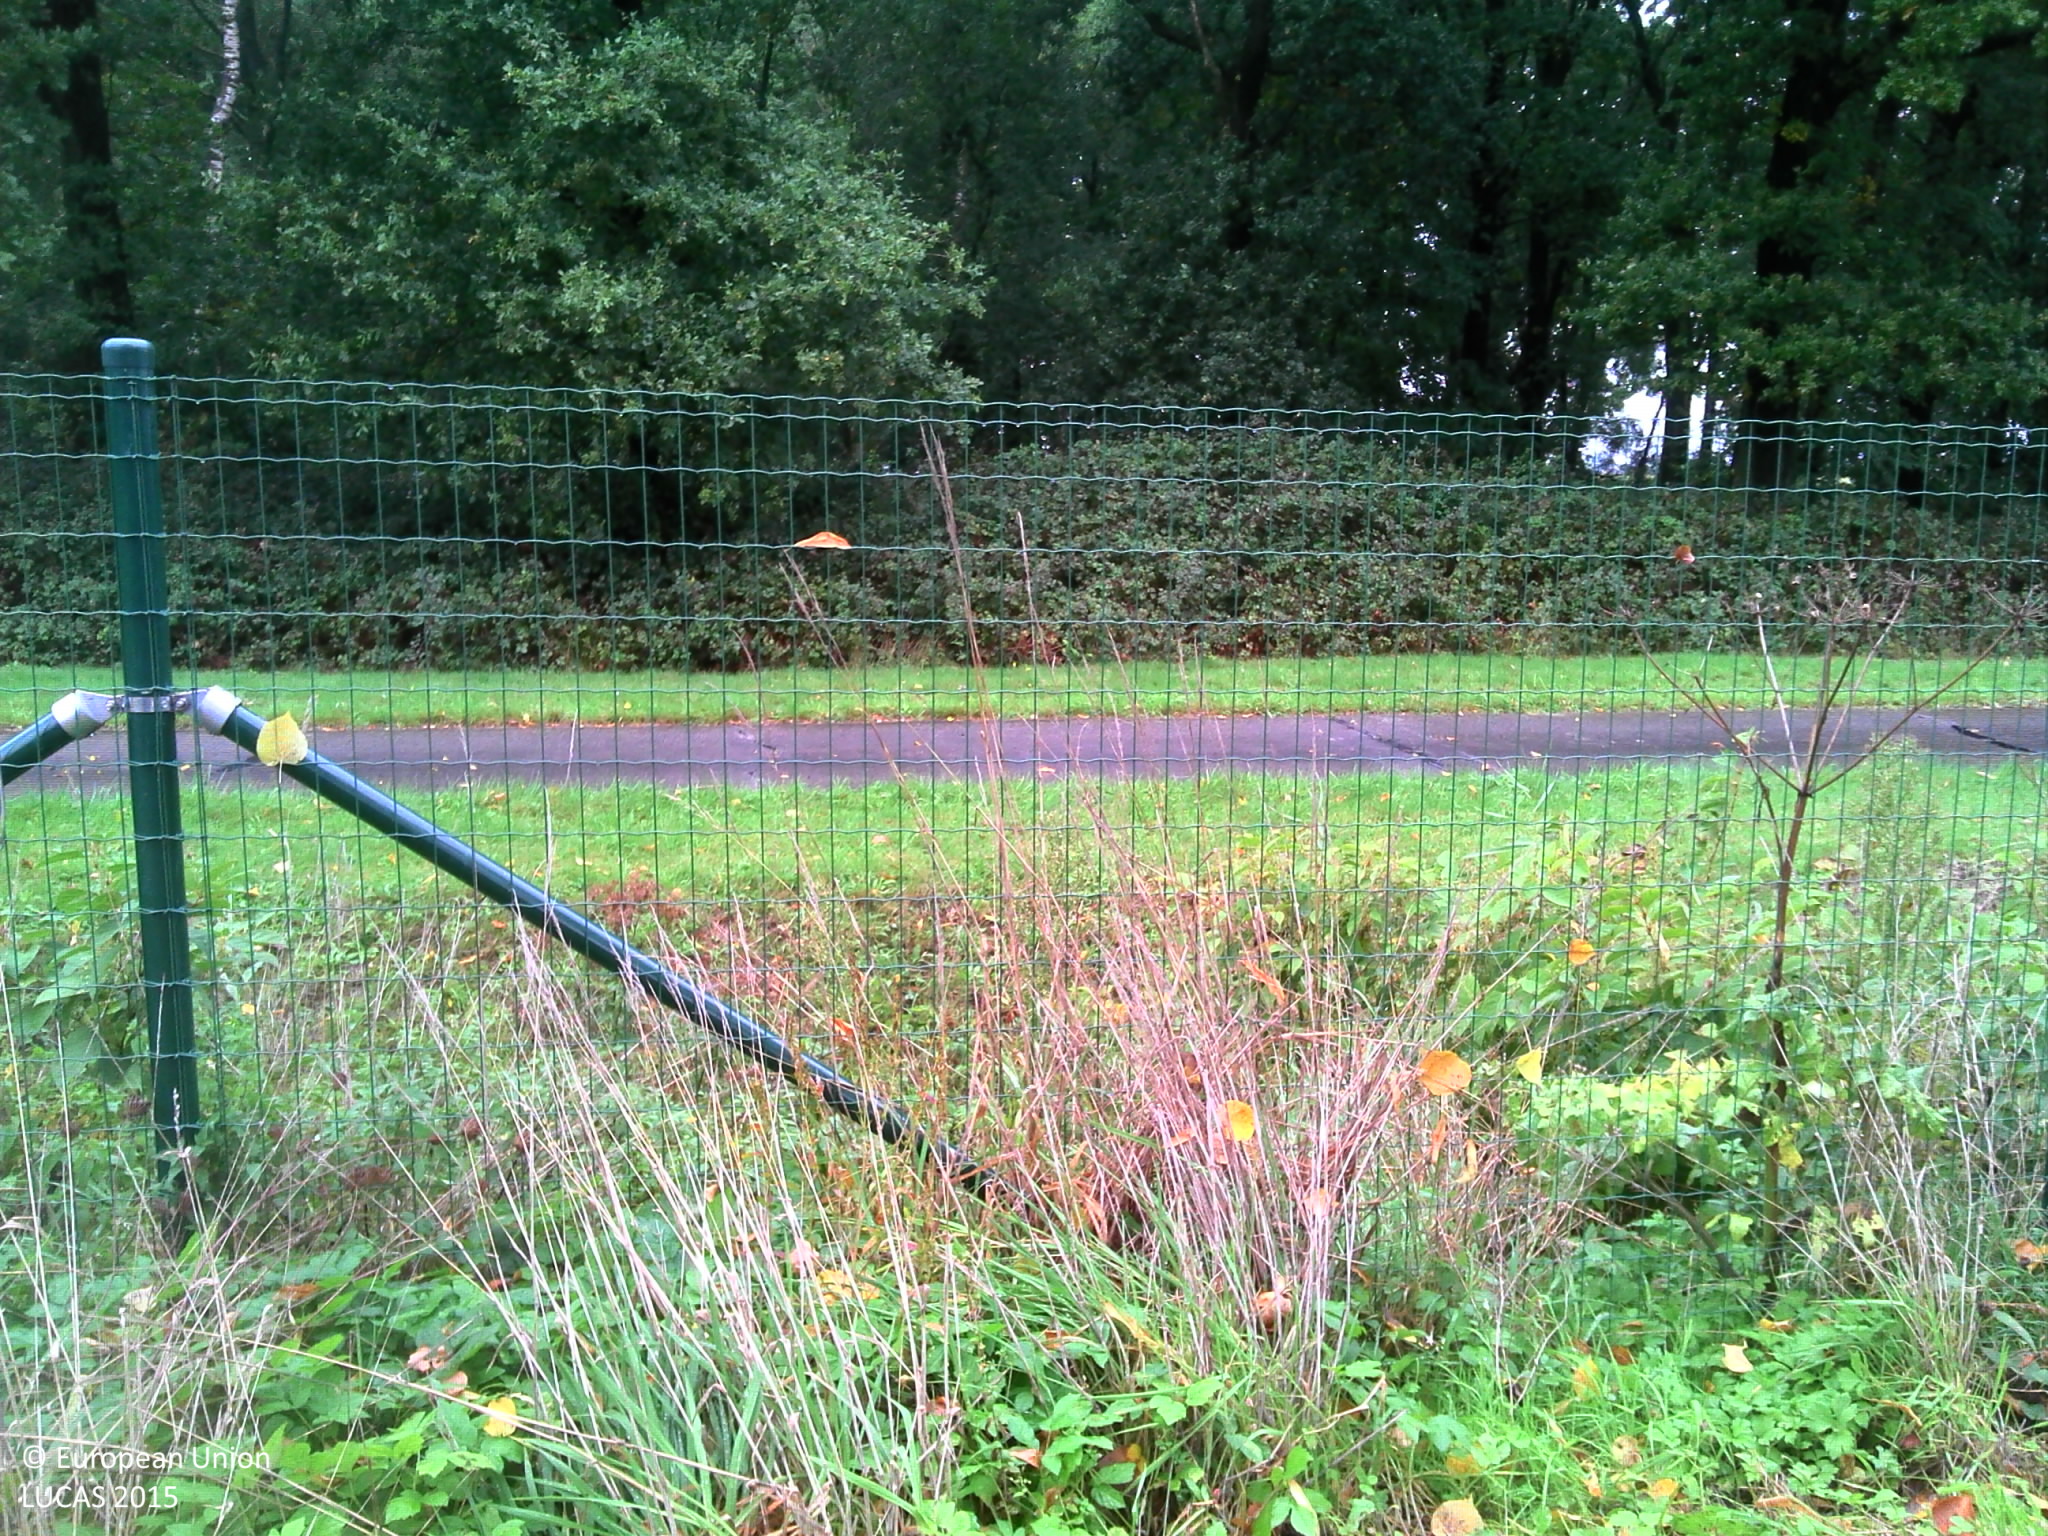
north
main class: Cropland
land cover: Other fibre and oleaginous crops
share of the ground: 50 - 75 %
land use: Agriculture (excluding fallow land and kitchen gardens)
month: October
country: BE
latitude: 50.9599
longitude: 2.9707
